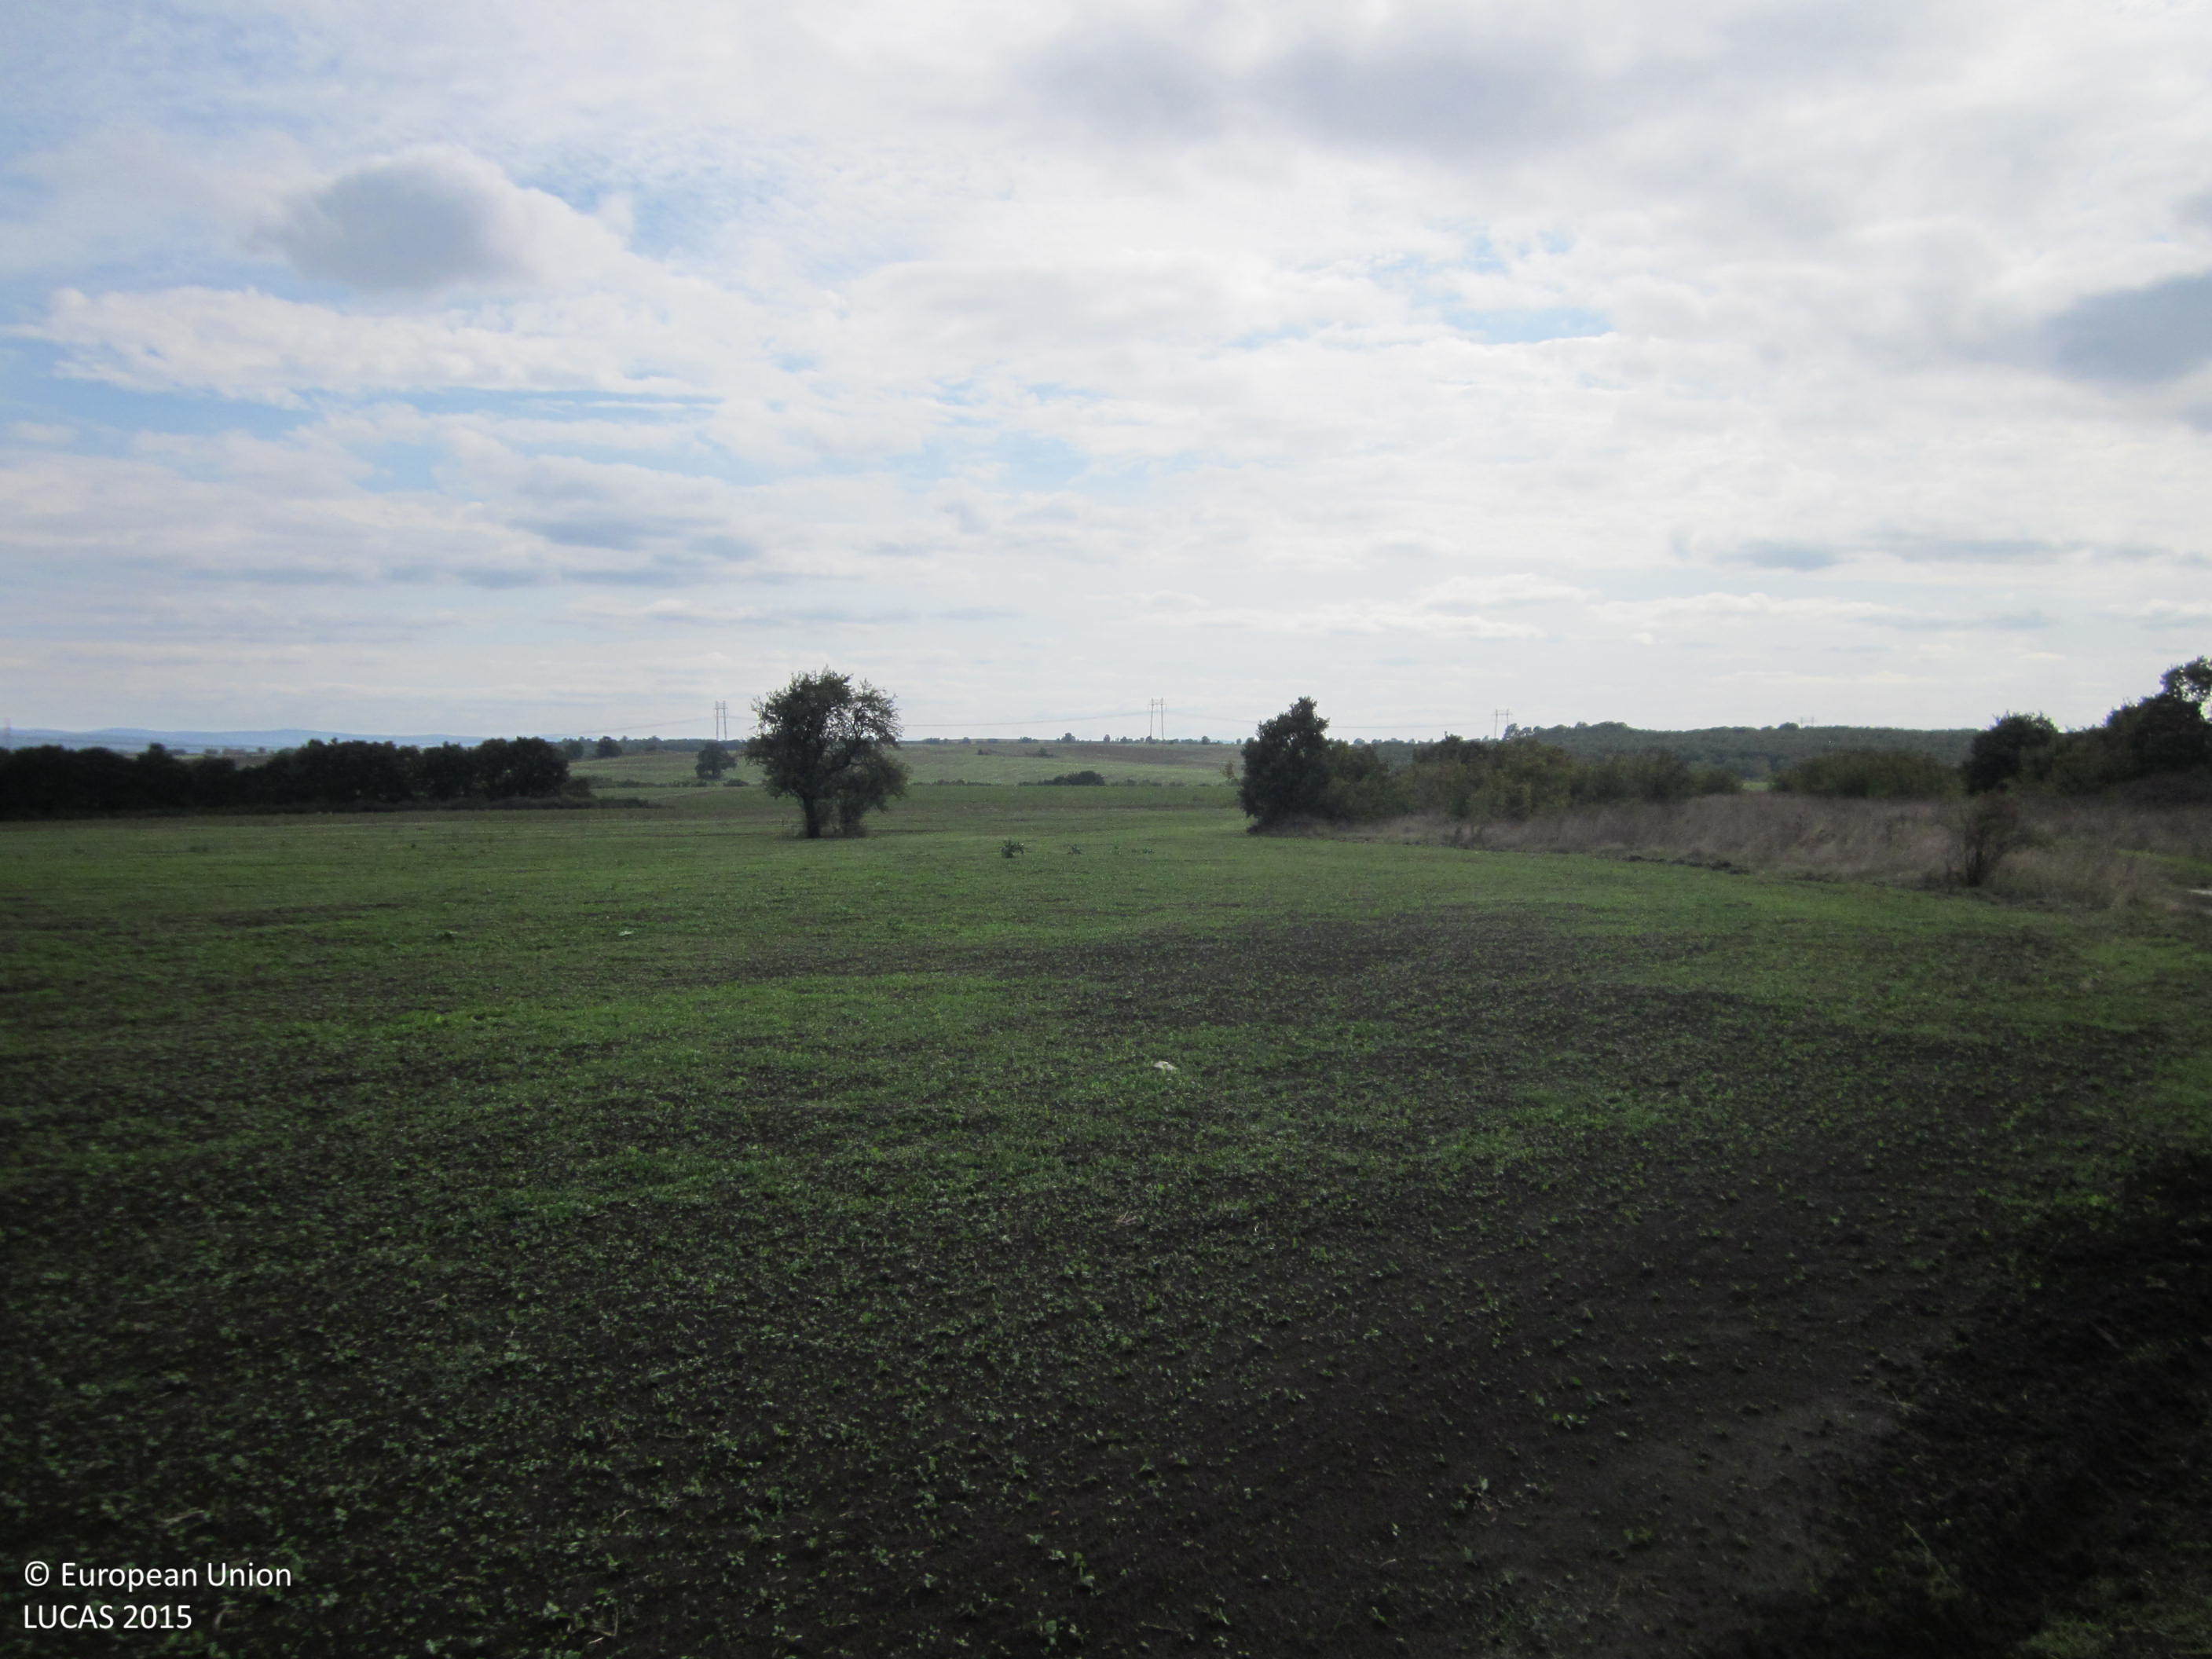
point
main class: Grassland
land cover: Spontaneously vegetated surfaces
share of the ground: > 75 %
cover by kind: herbaceous plants 100 %
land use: Fallow land
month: October
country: BG
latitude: 42.3442
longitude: 27.0117
